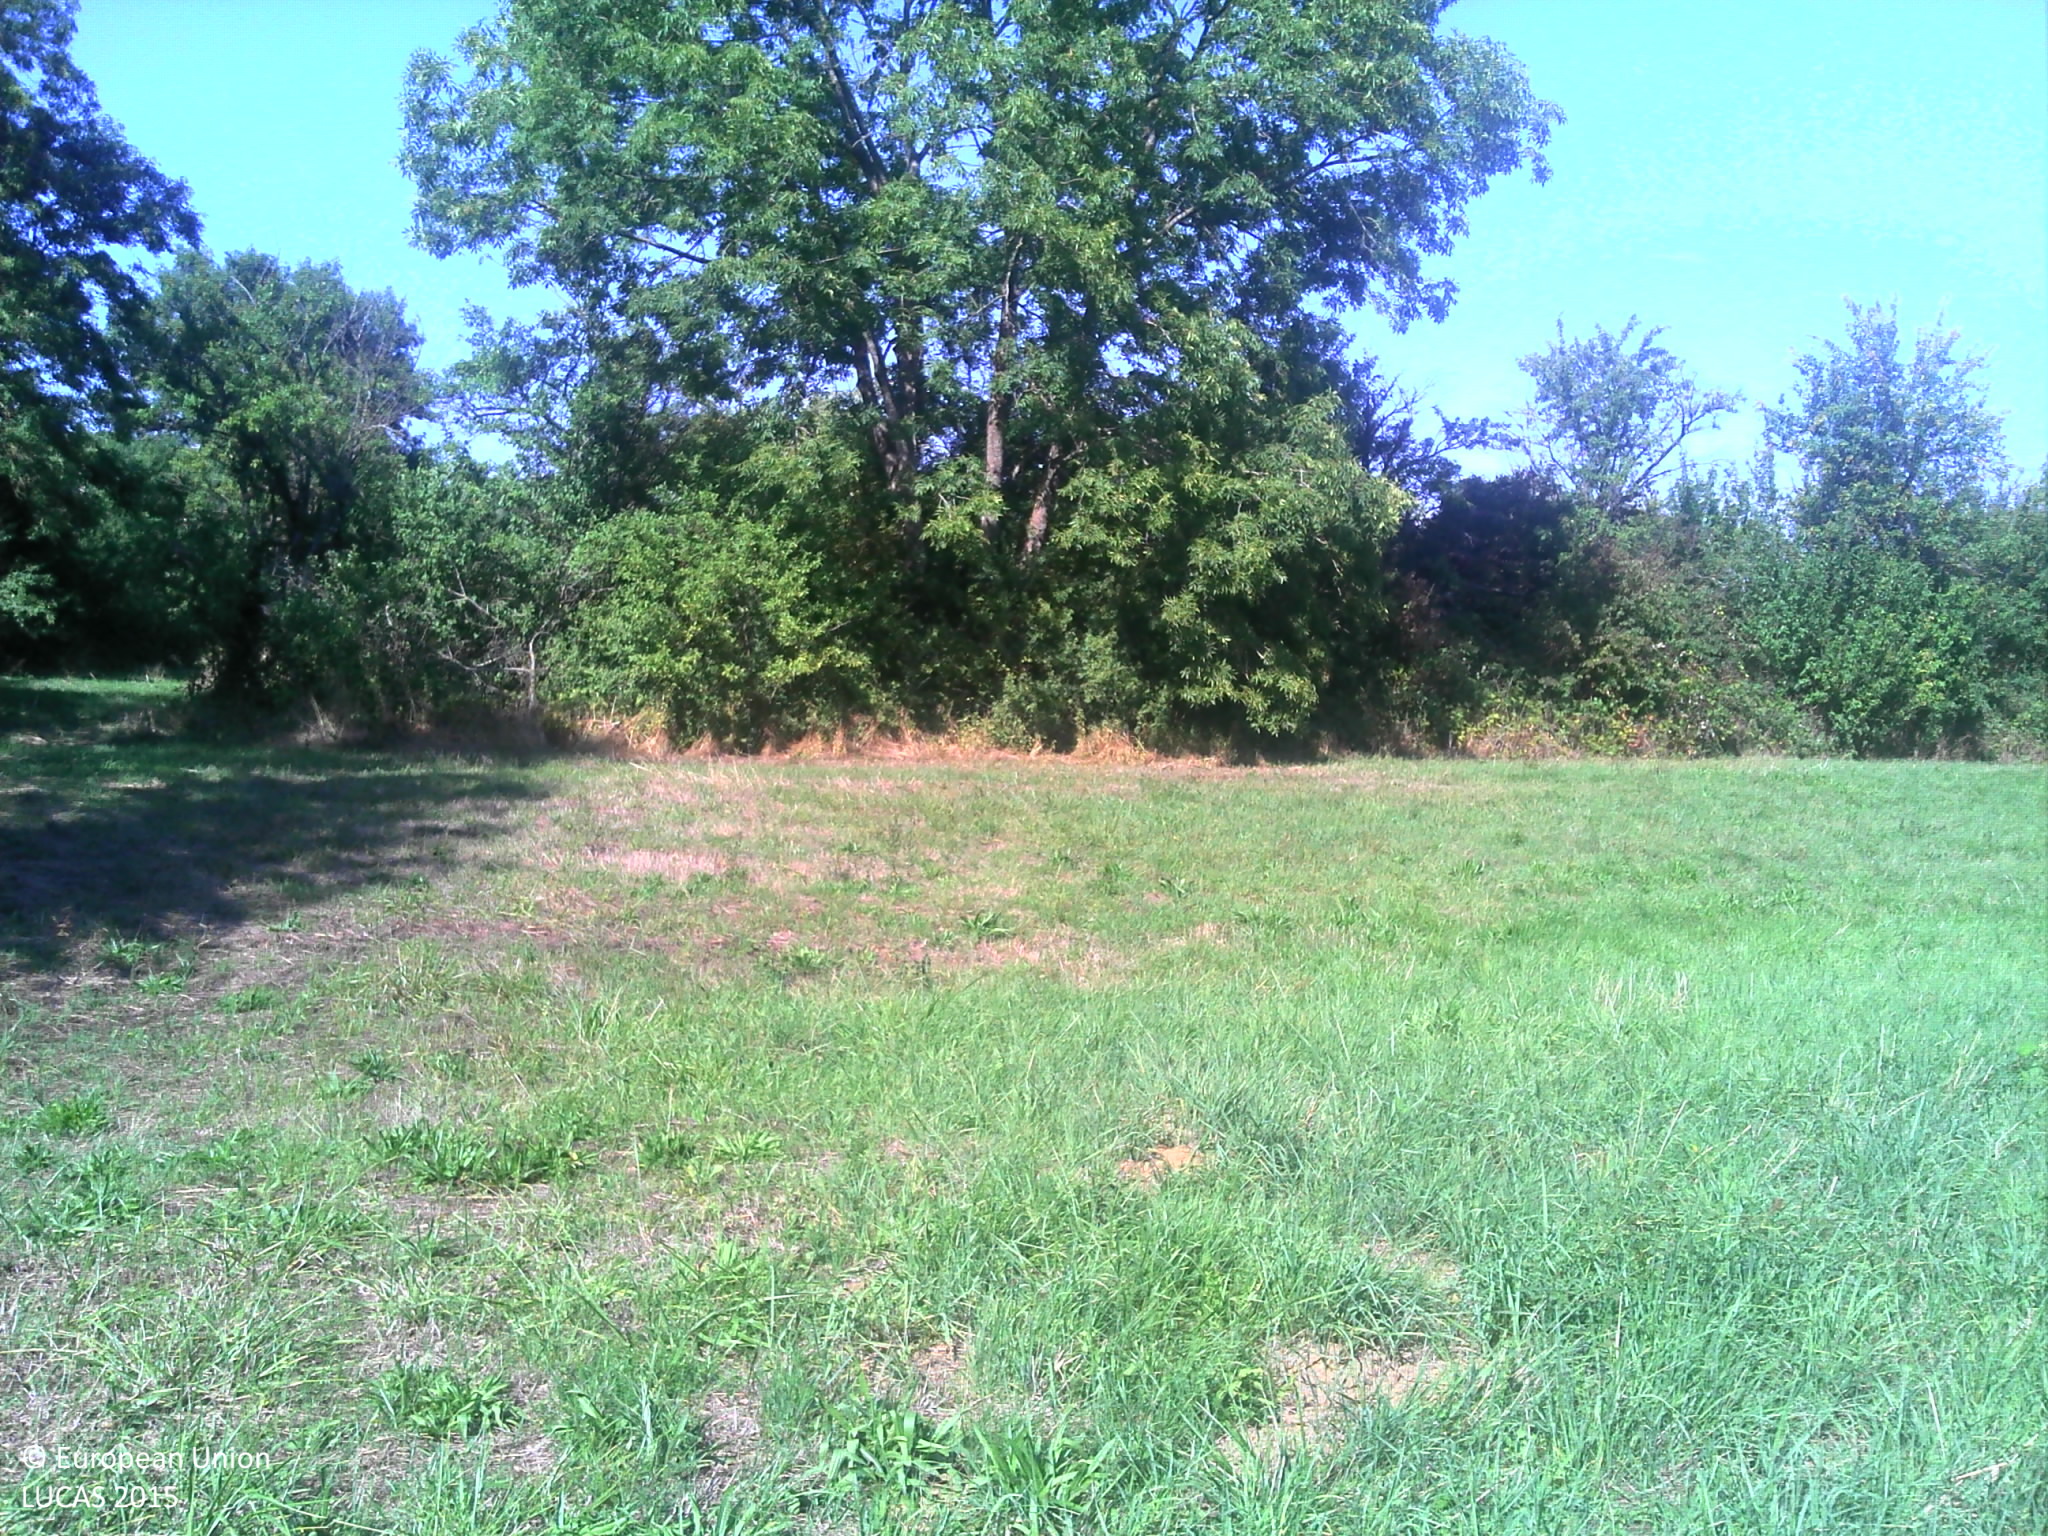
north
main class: Cropland
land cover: Other fruit trees and berries
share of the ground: > 75 %
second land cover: Grassland without tree/shrub cover
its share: > 75 %
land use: Agriculture (excluding fallow land and kitchen gardens)
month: September
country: FR
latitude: 48.8264
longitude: 6.2541
